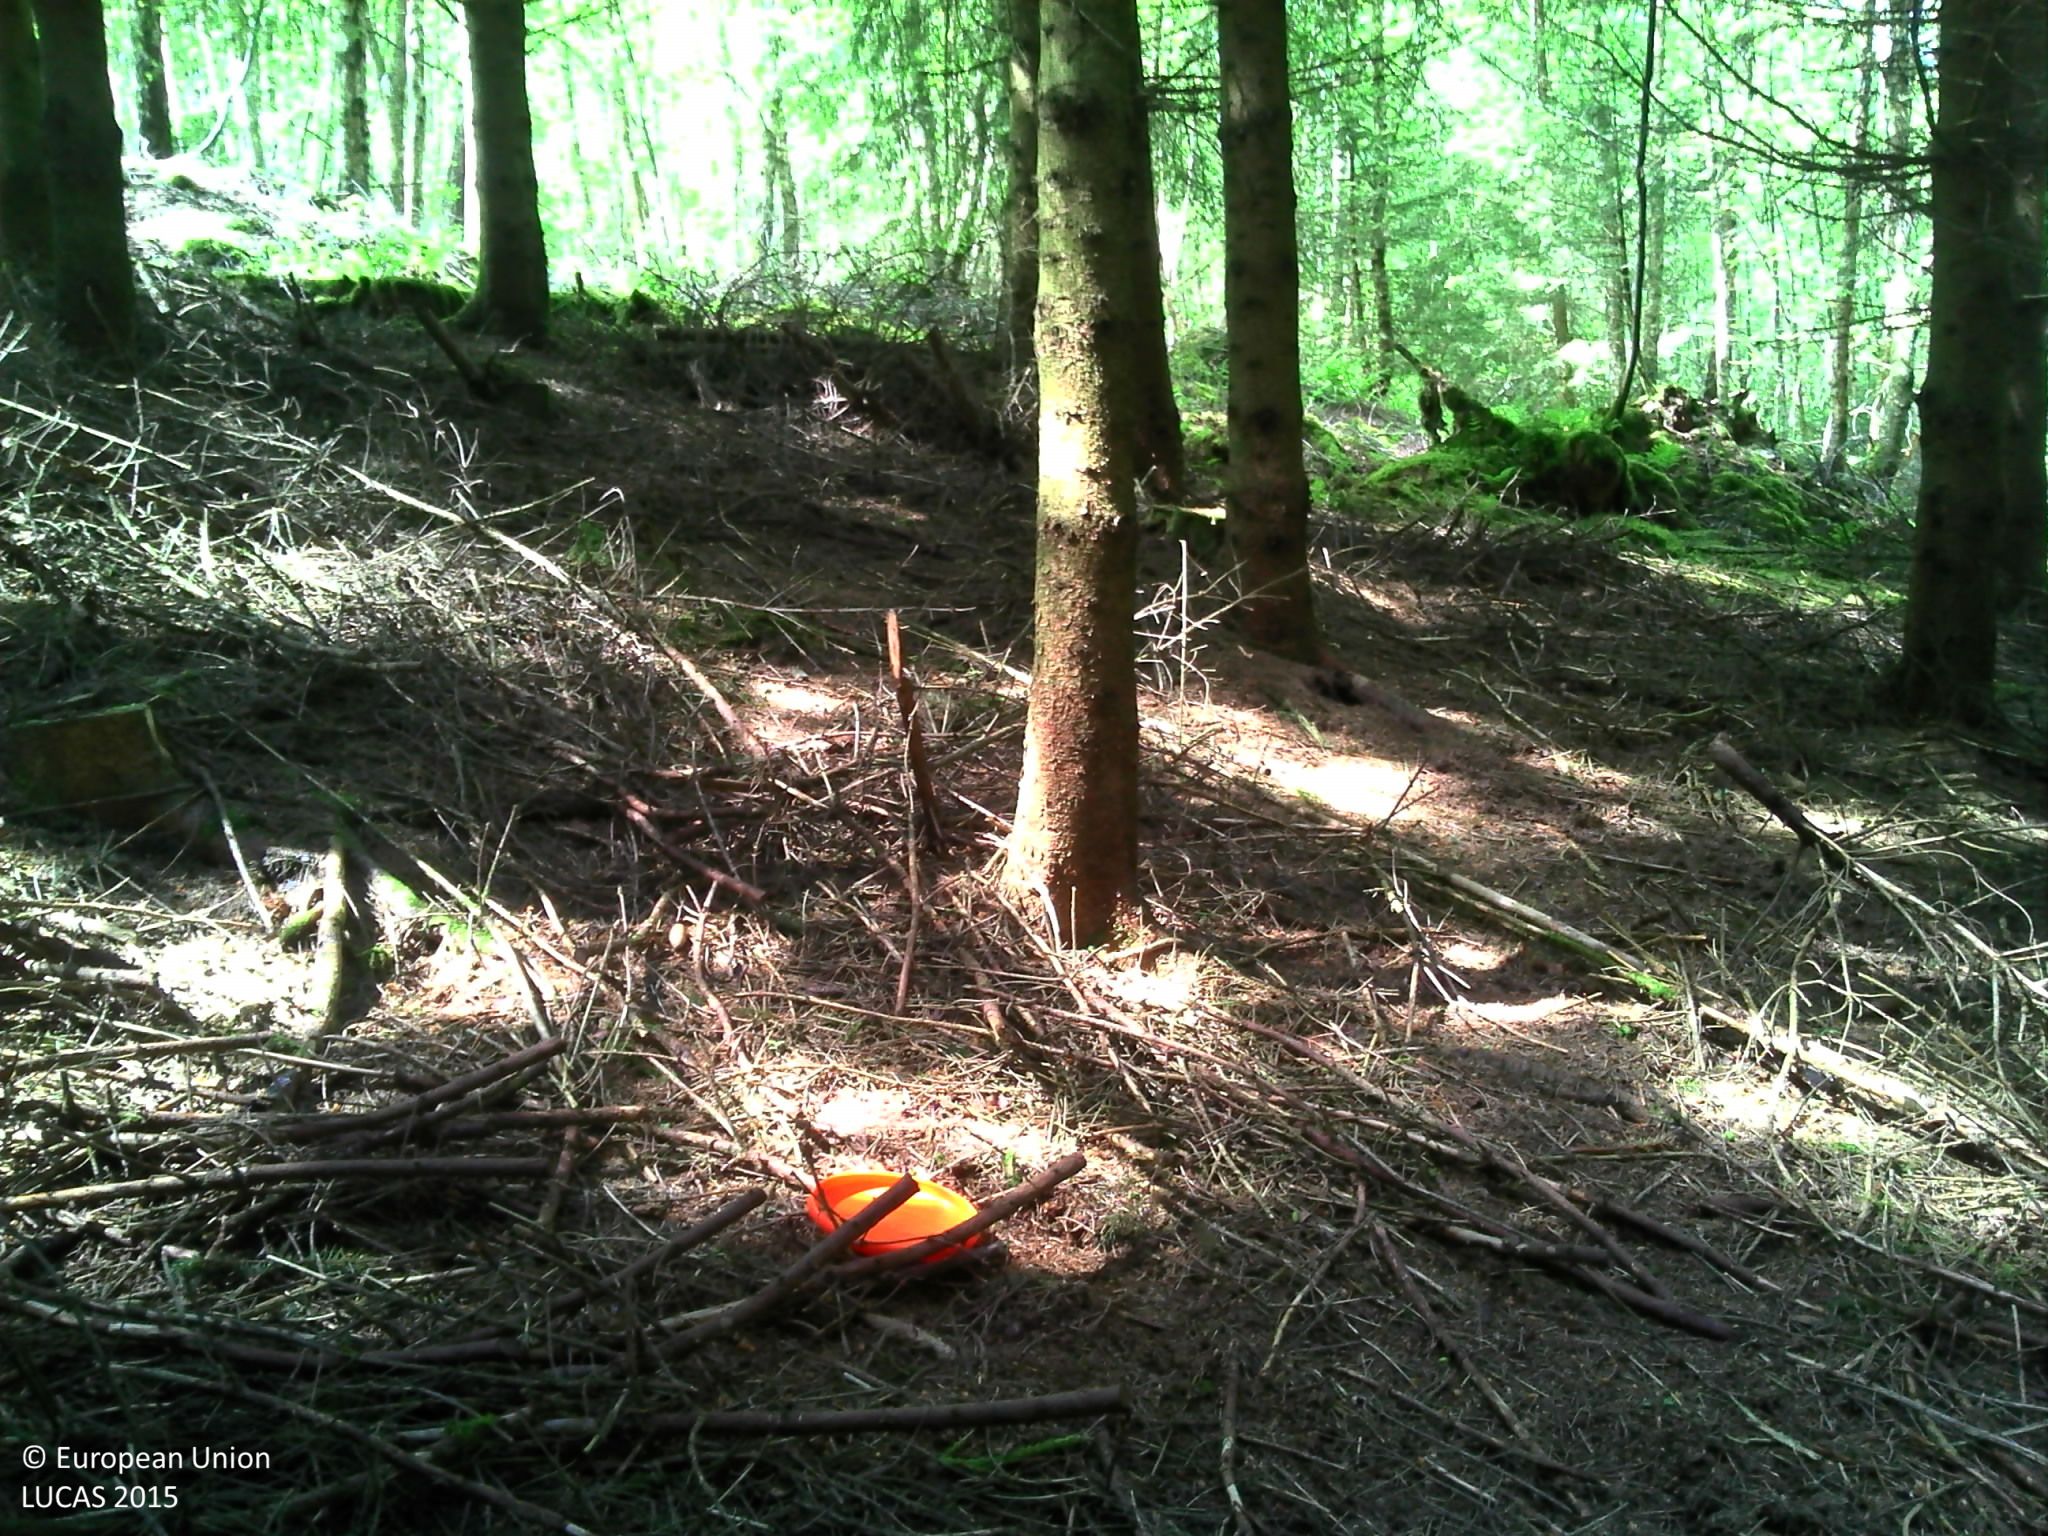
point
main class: Woodland
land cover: Spruce dominated coniferous woodland
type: exotic forest
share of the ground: > 75 %
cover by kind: coniferous forest trees 90 %, broadleaved forest trees 5 %, lichens and mosses 5 %
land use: Forestry
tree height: > 5 m
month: May
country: LU
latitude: 50.1306
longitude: 5.9562
